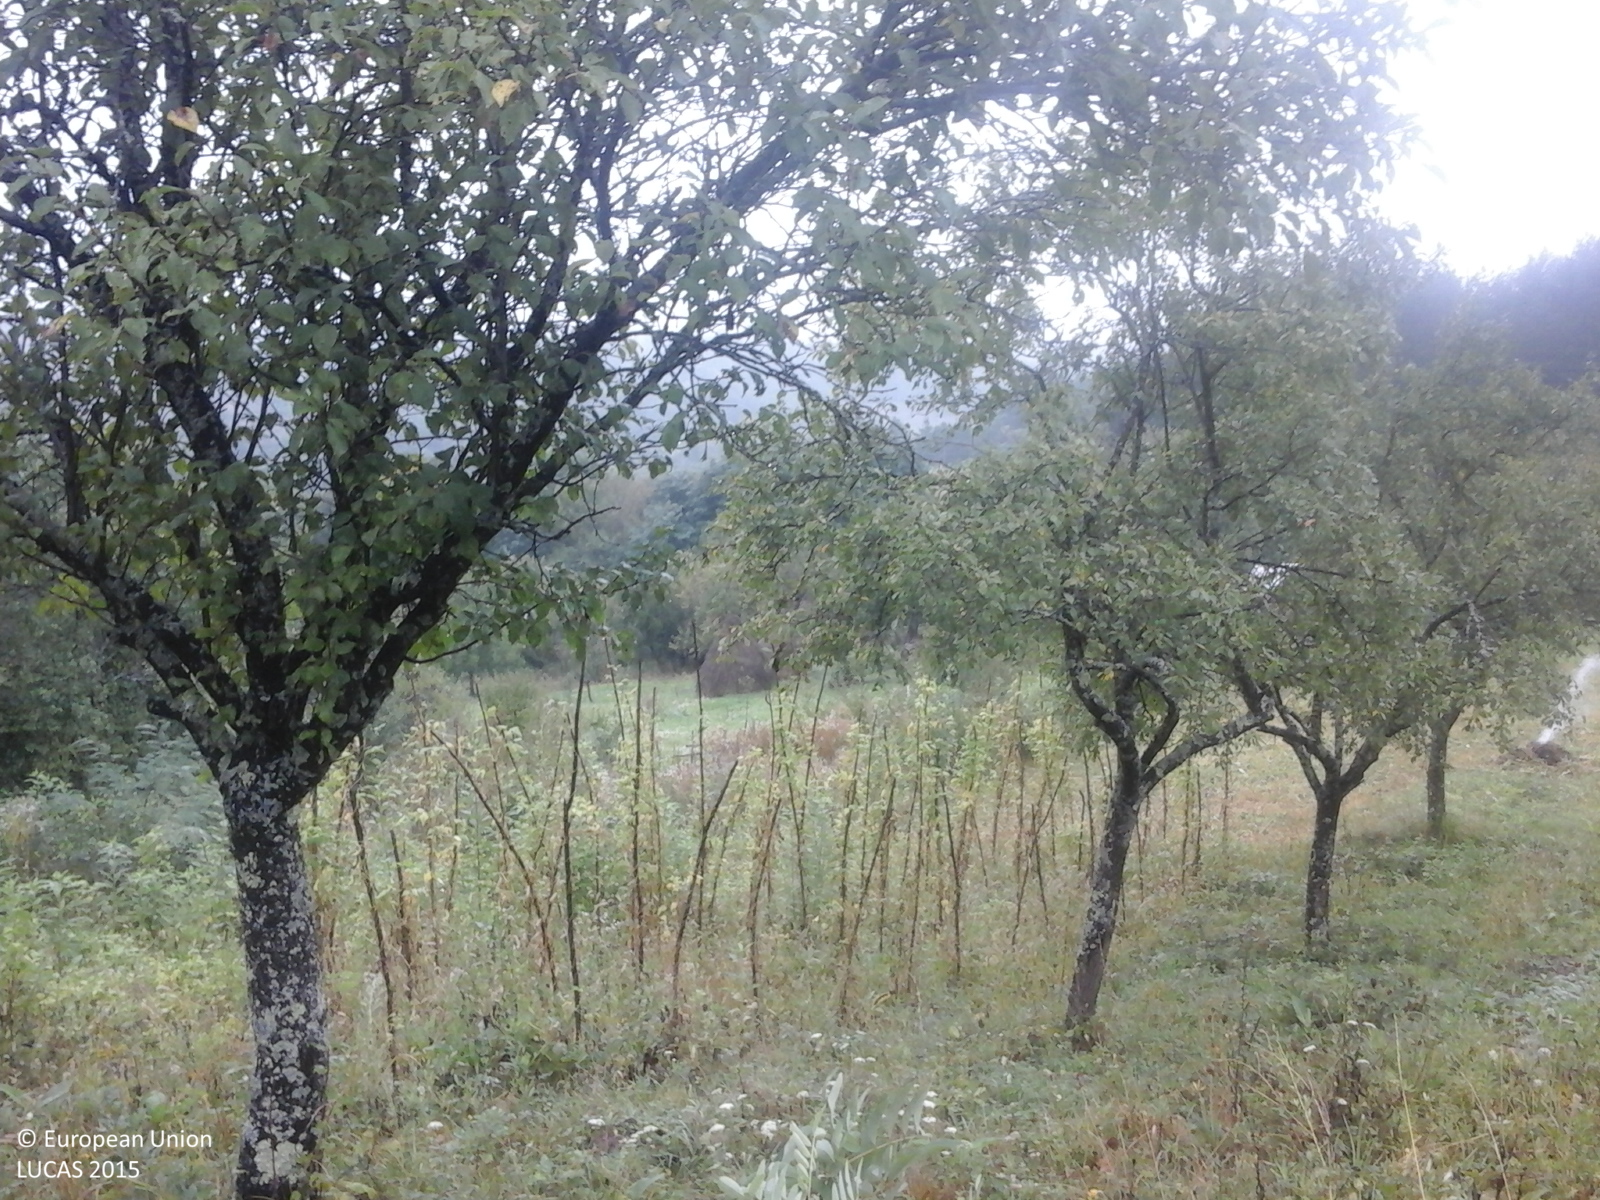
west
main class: Woodland
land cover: Broadleaved woodland
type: mesophytic deciduous forest
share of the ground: > 75 %
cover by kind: broadleaved forest trees 75 %, shrubs 25 %
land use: Semi-natural and natural areas not in use
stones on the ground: < 10 %
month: September
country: RO
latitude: 47.0511
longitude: 22.5209
